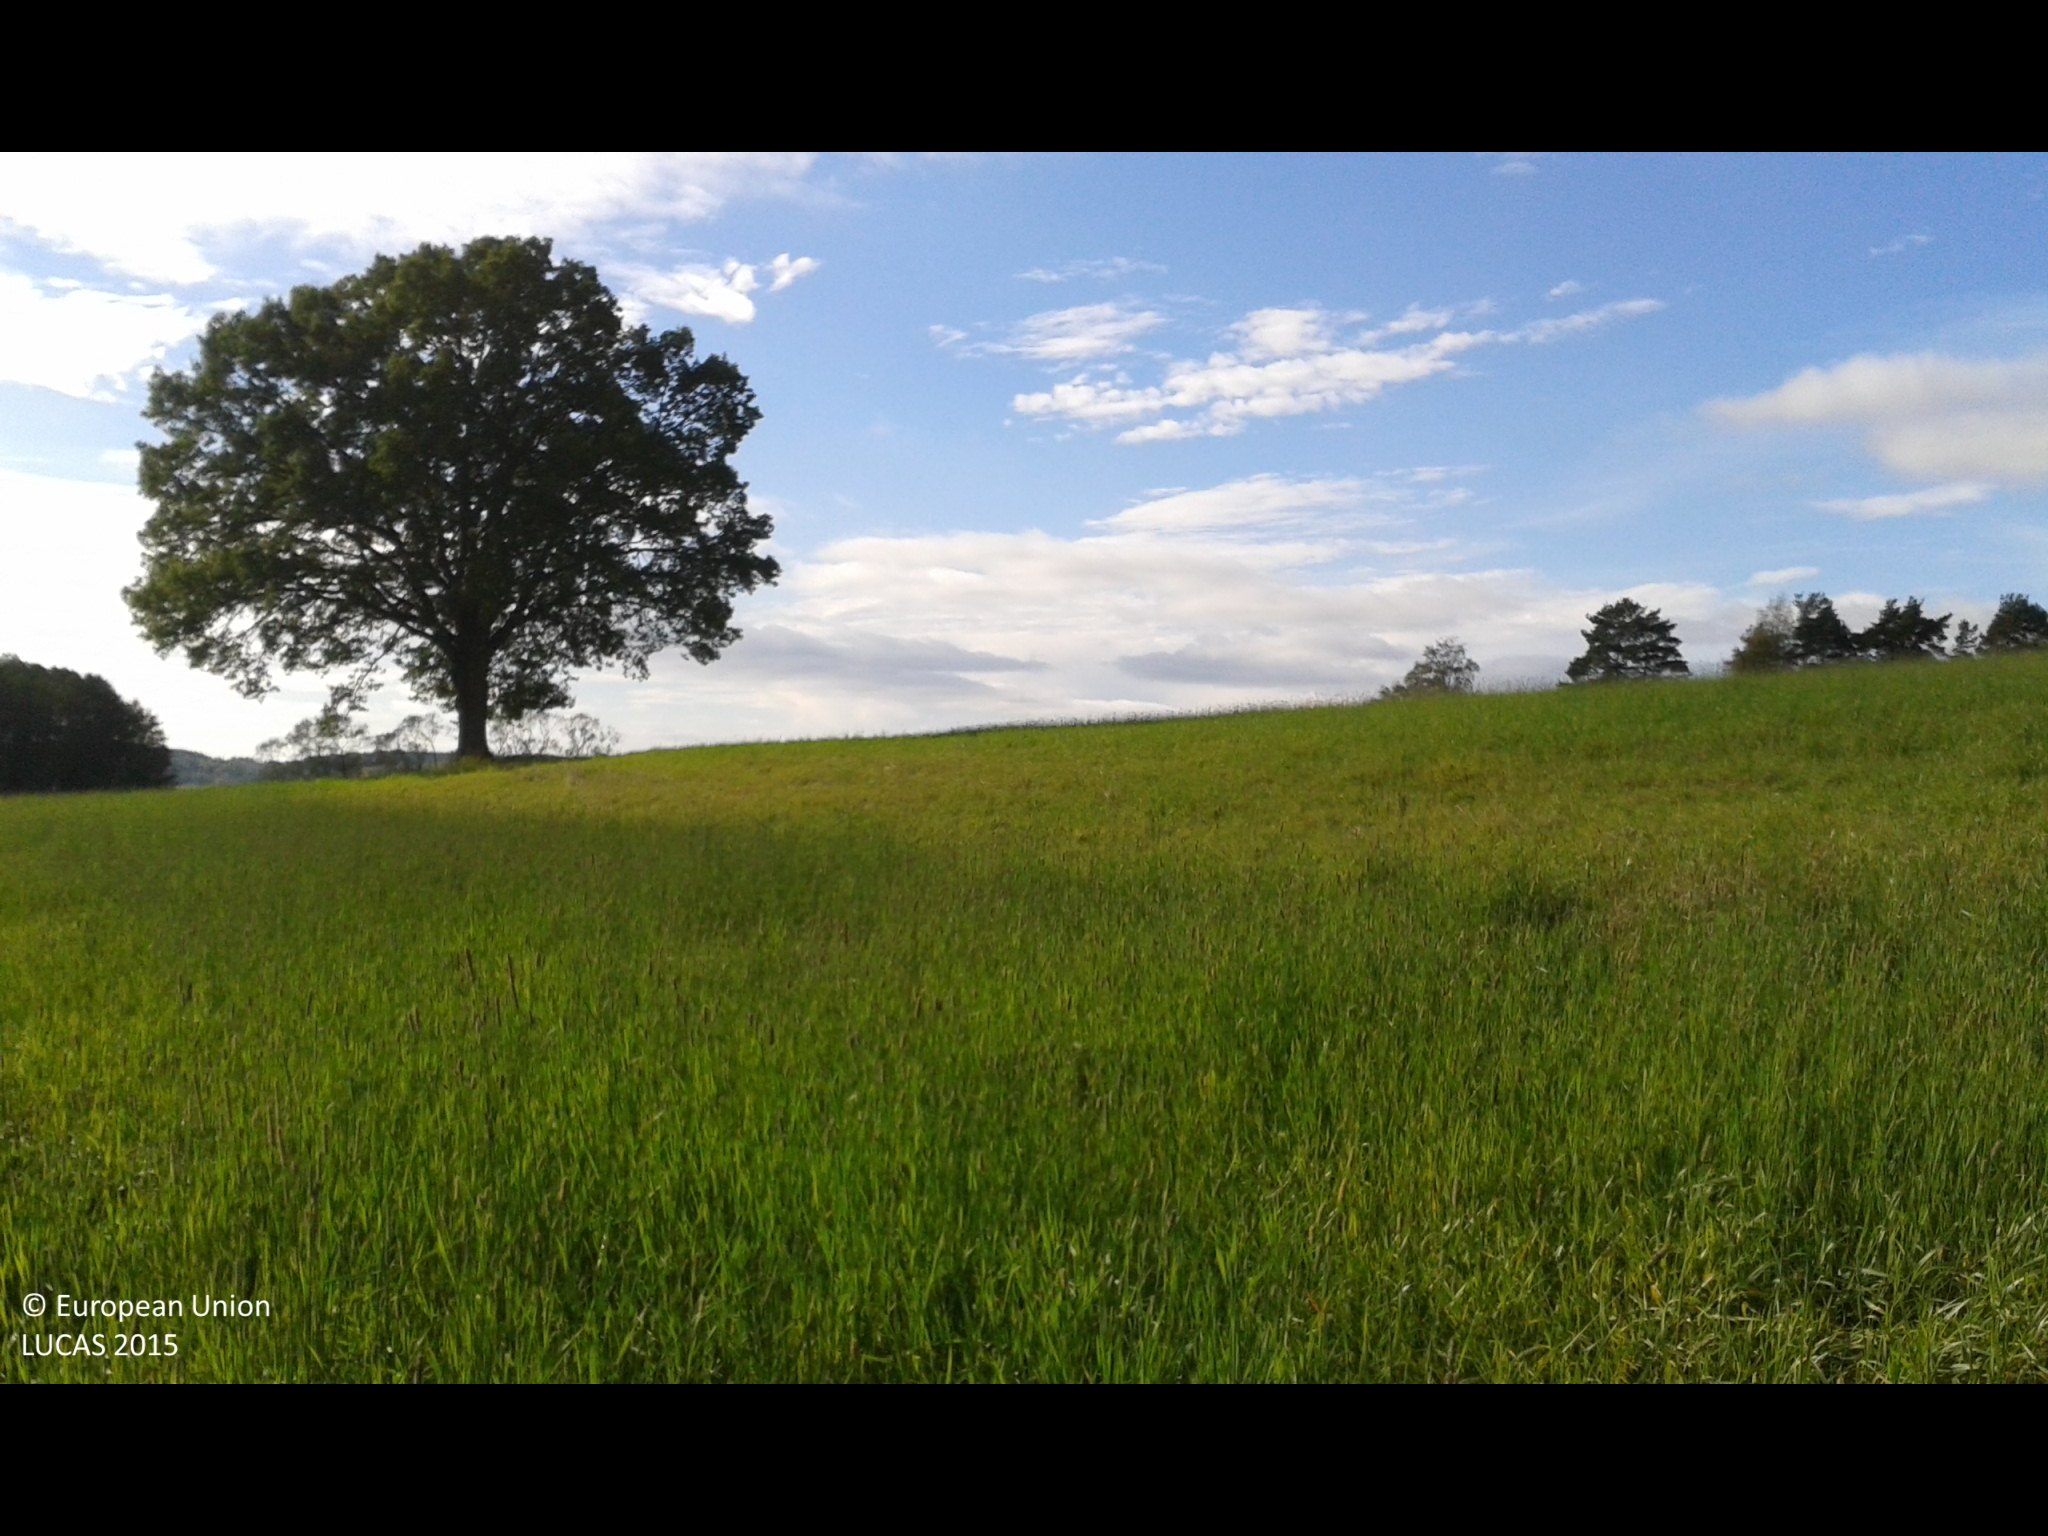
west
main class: Grassland
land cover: Grassland without tree/shrub cover
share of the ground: > 75 %
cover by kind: herbaceous plants 100 %
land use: Agriculture (excluding fallow land and kitchen gardens)
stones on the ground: < 10 %
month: October
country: SE
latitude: 58.9190
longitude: 17.0645
